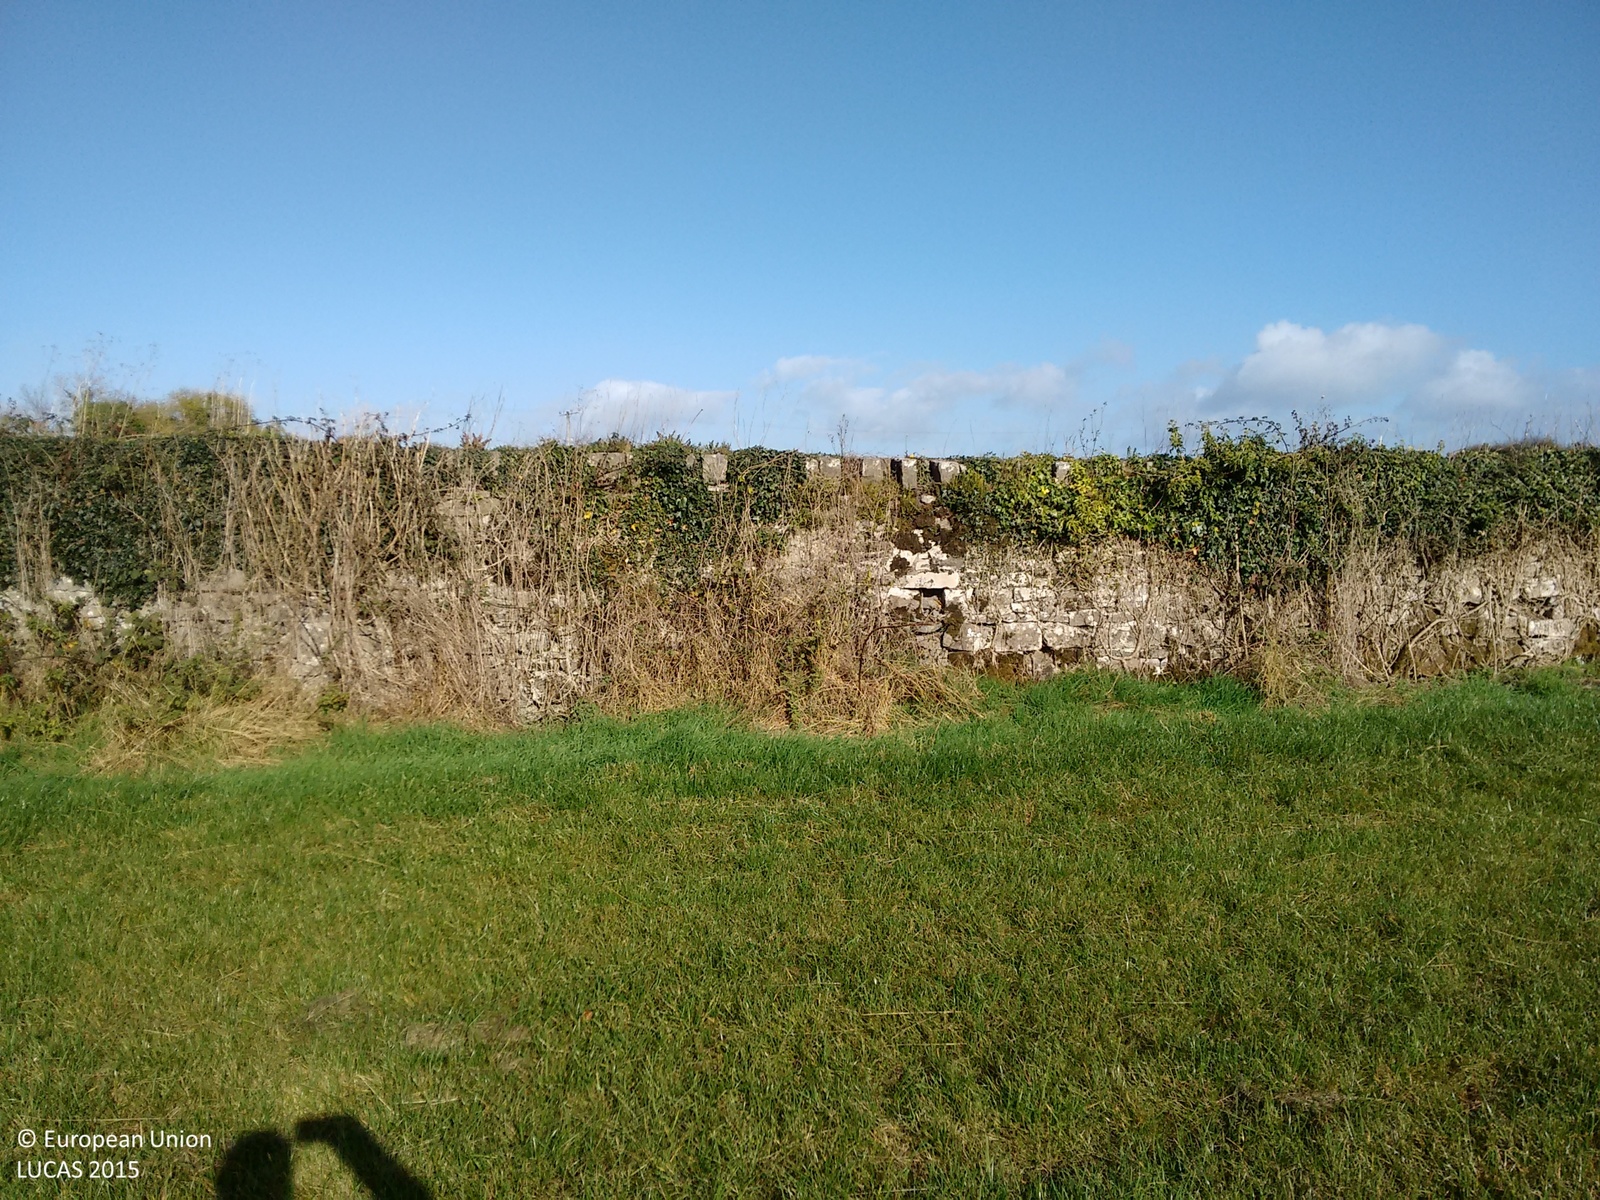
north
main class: Grassland
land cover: Grassland without tree/shrub cover
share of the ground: > 75 %
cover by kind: herbaceous plants 100 %
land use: Agriculture (excluding fallow land and kitchen gardens)
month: October
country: IE
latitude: 52.8038
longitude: -7.8060
